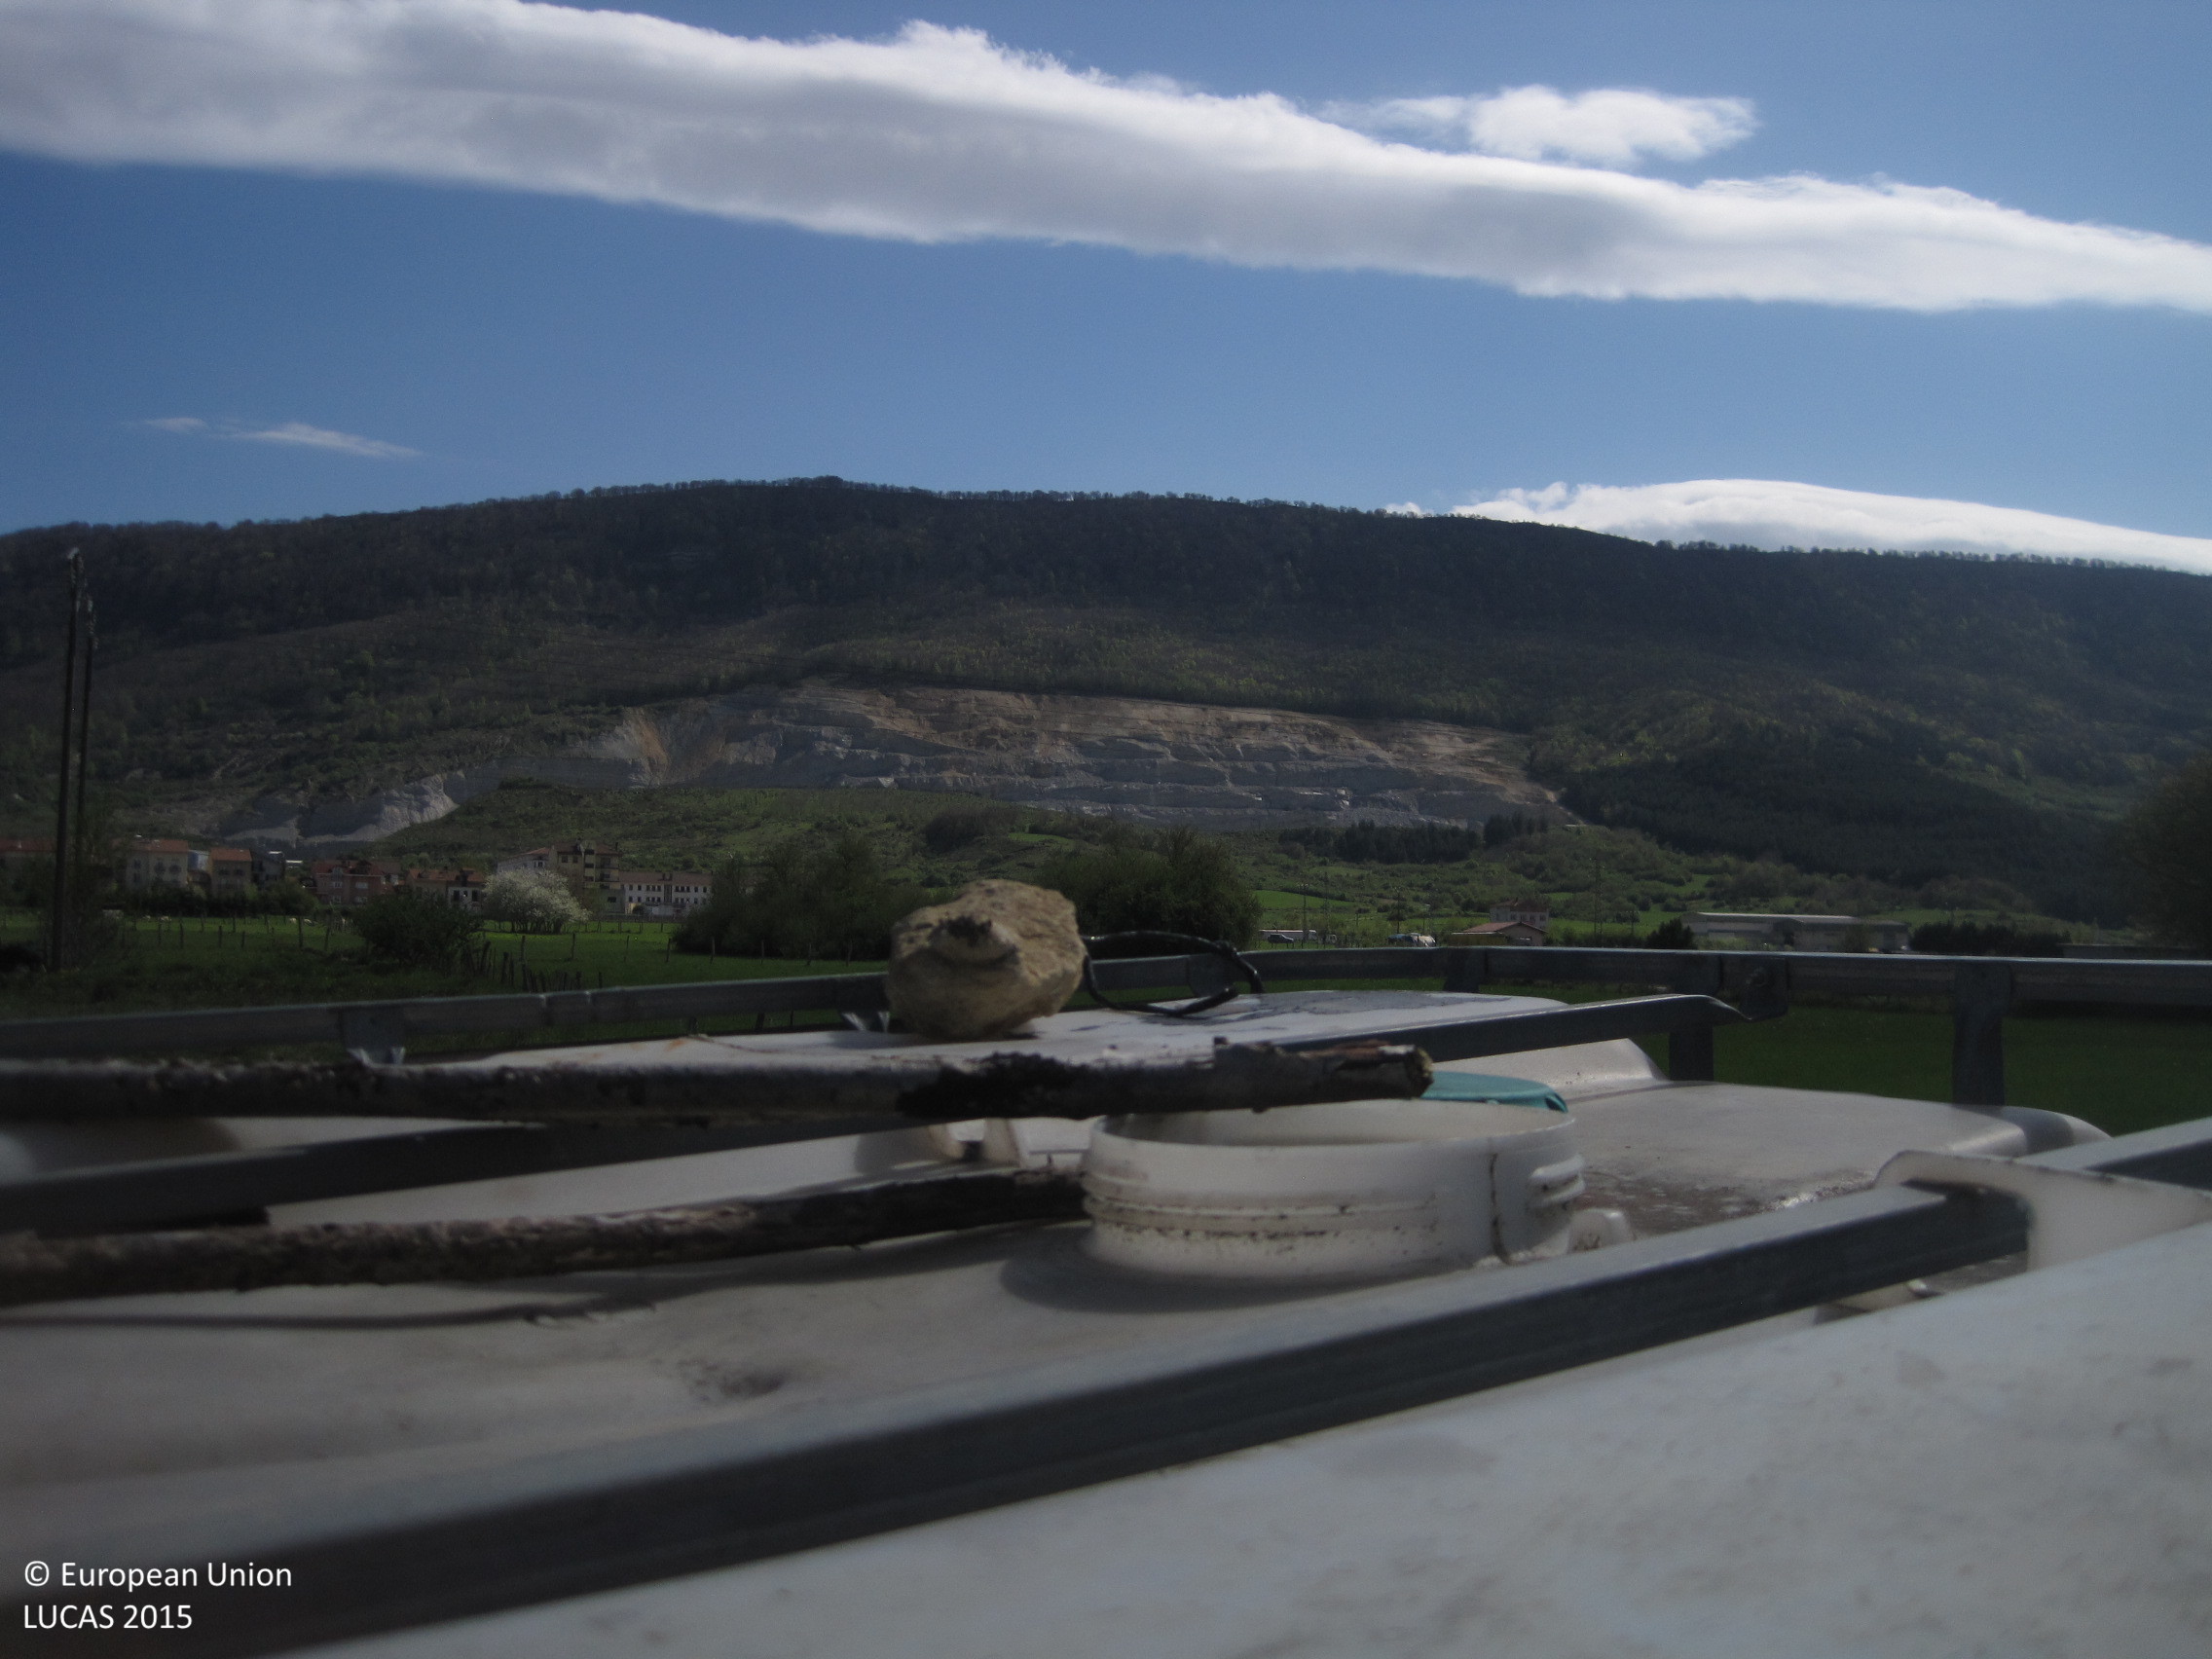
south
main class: Cropland
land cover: Other root crops
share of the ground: 10 - 25 %
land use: Kitchen garden
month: April
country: ES
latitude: 42.8799
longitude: -2.2031
